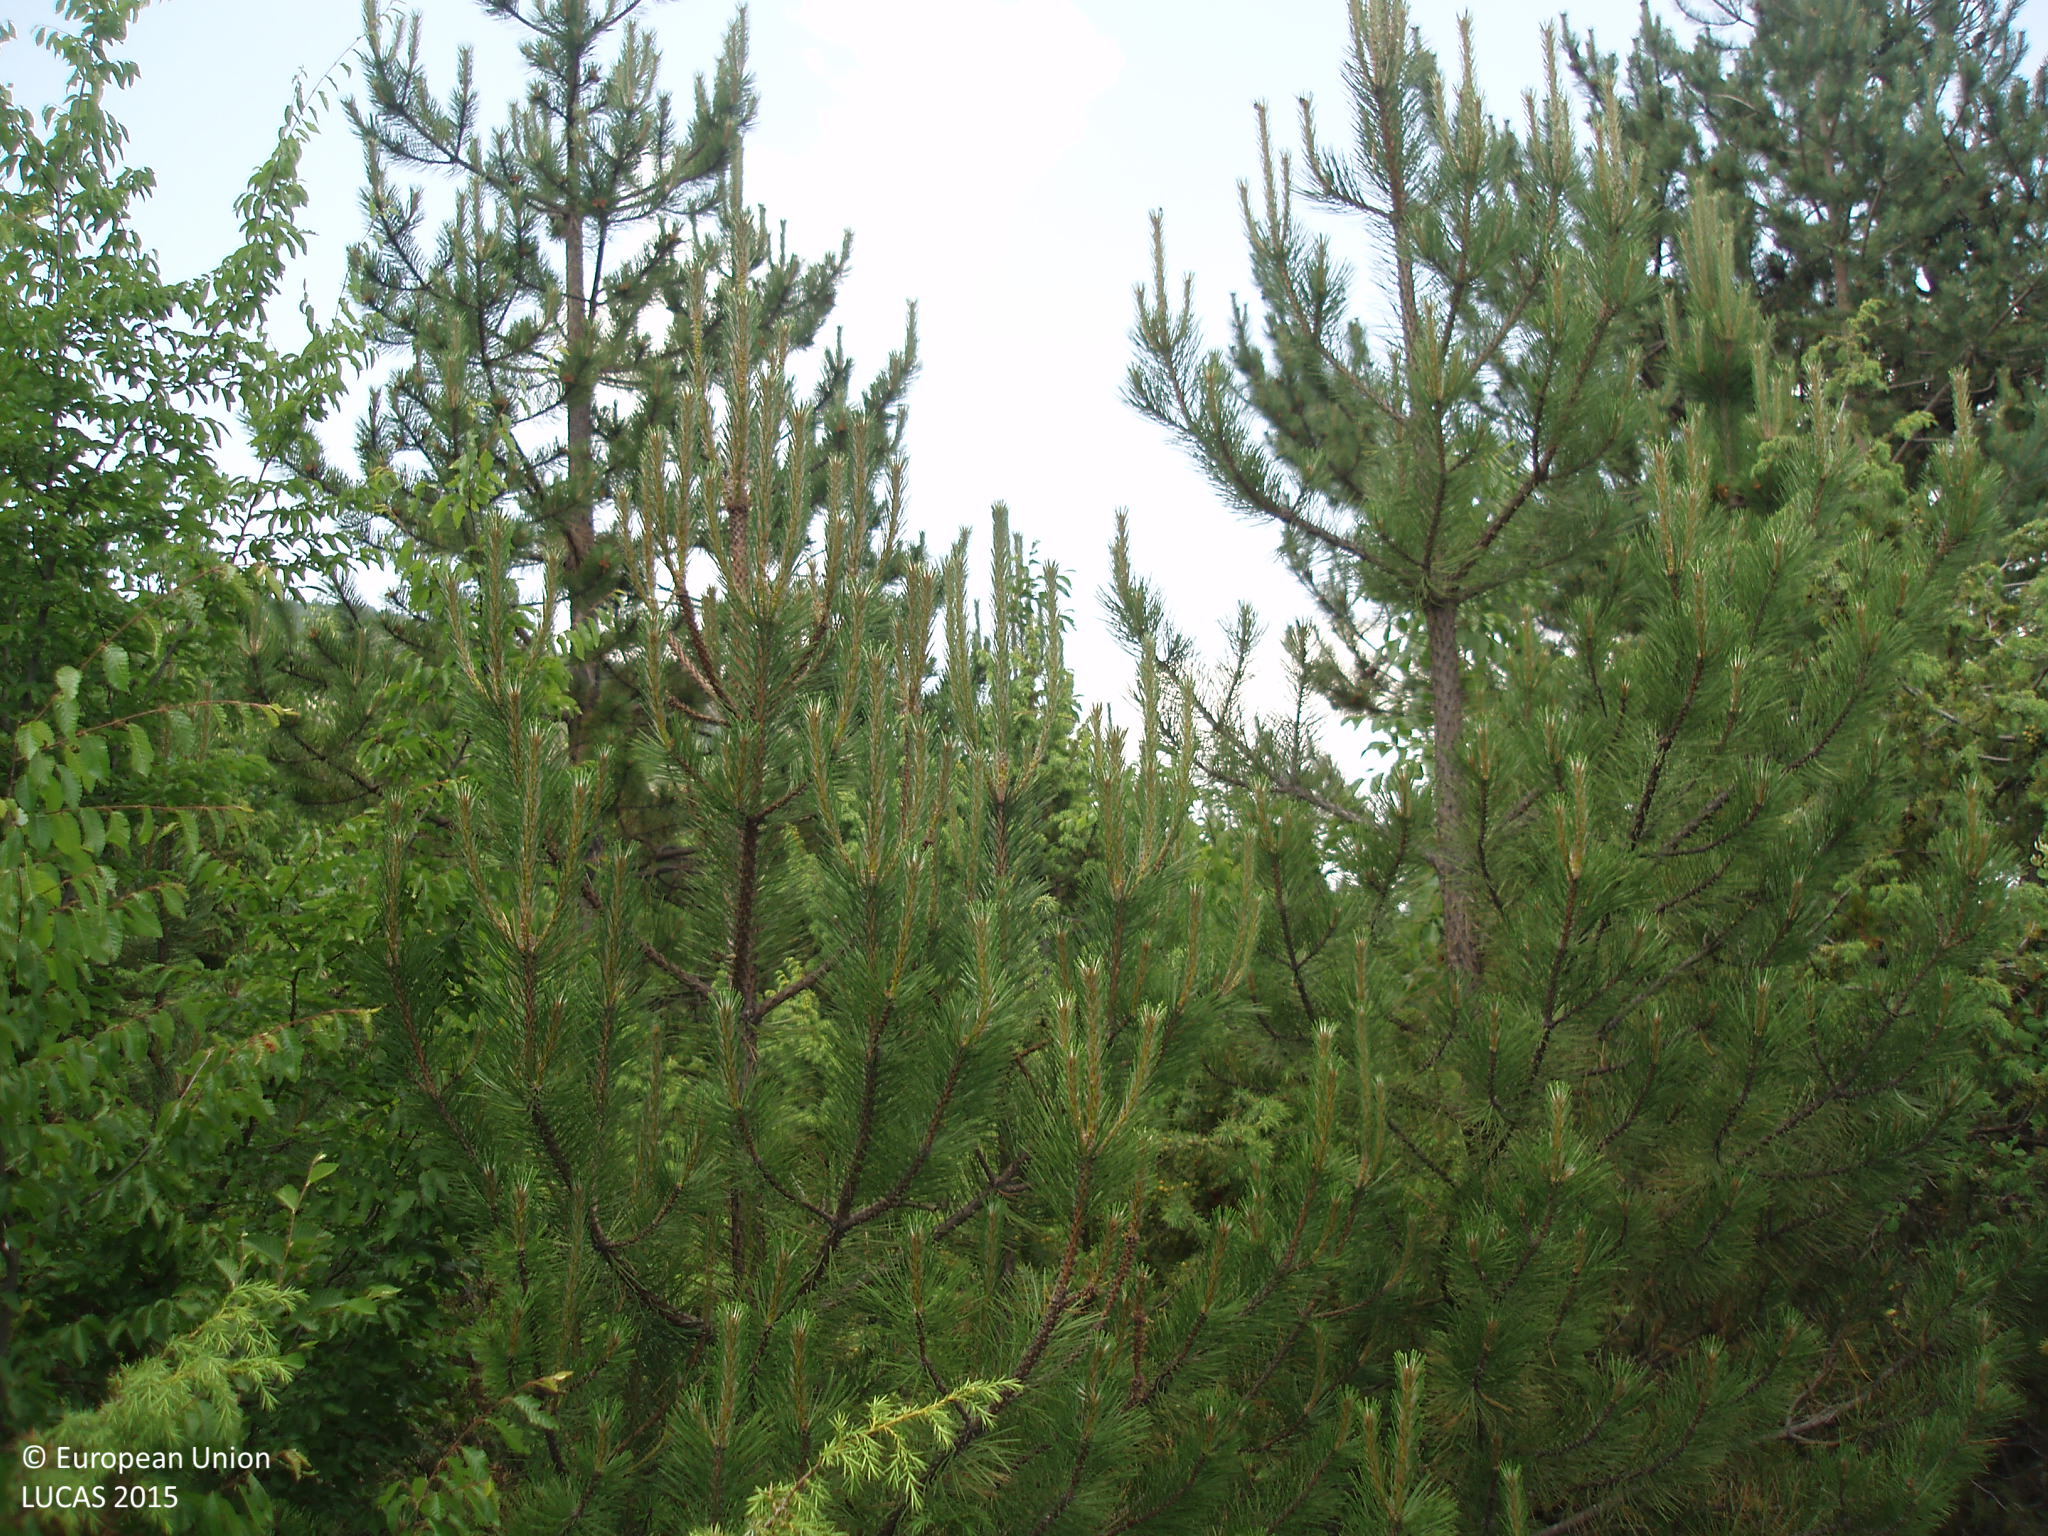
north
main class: Woodland
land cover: Other mixed woodland
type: hemiboreal forest and nemoral coniferous forest and mixed broadleaved-coniferous forest
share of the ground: > 75 %
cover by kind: coniferous forest trees 75 %, broadleaved forest trees 25 %
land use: Forestry
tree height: > 5 m
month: June
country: BG
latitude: 41.4073
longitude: 23.6989
